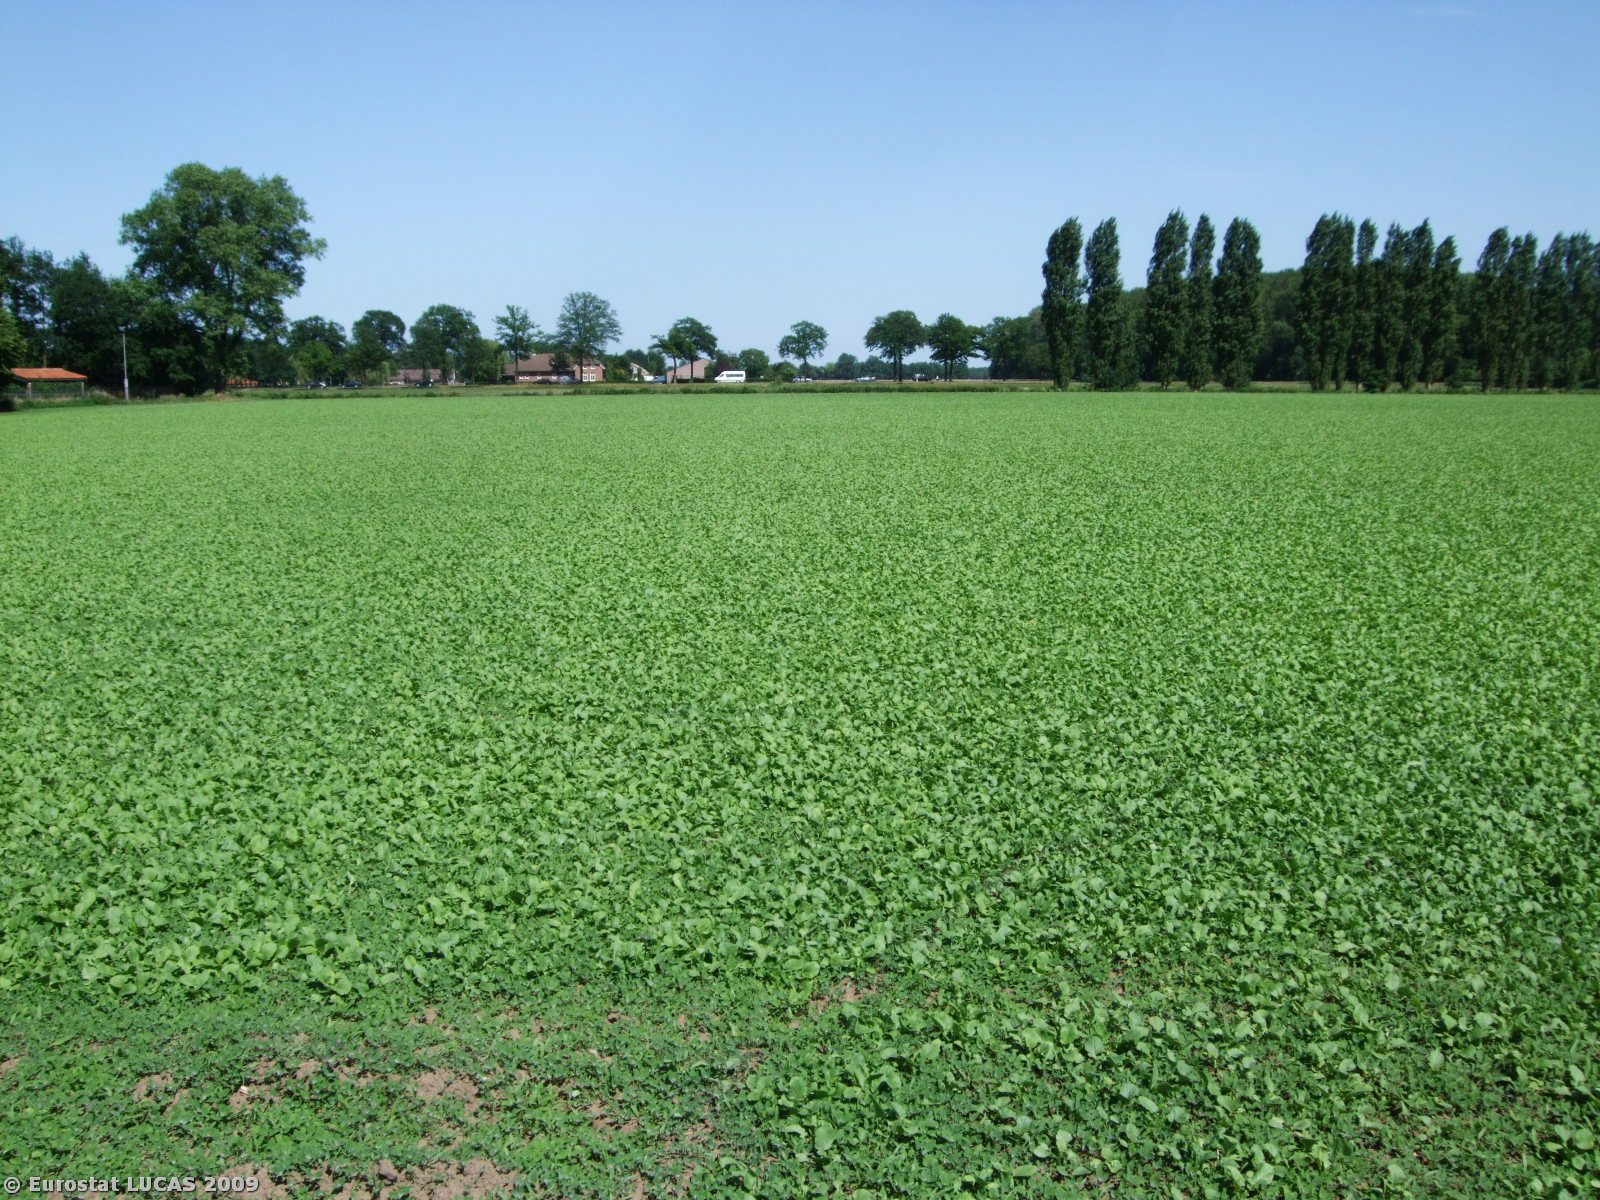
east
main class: Cropland
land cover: Other root crops
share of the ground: > 75 %
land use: Agriculture (excluding fallow land and kitchen gardens)
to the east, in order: Other root crops; Ditches and canals; Maize; Ditches and canals; Arable land (only in case pi)
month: June
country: NL
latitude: 51.5882
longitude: 5.4516
